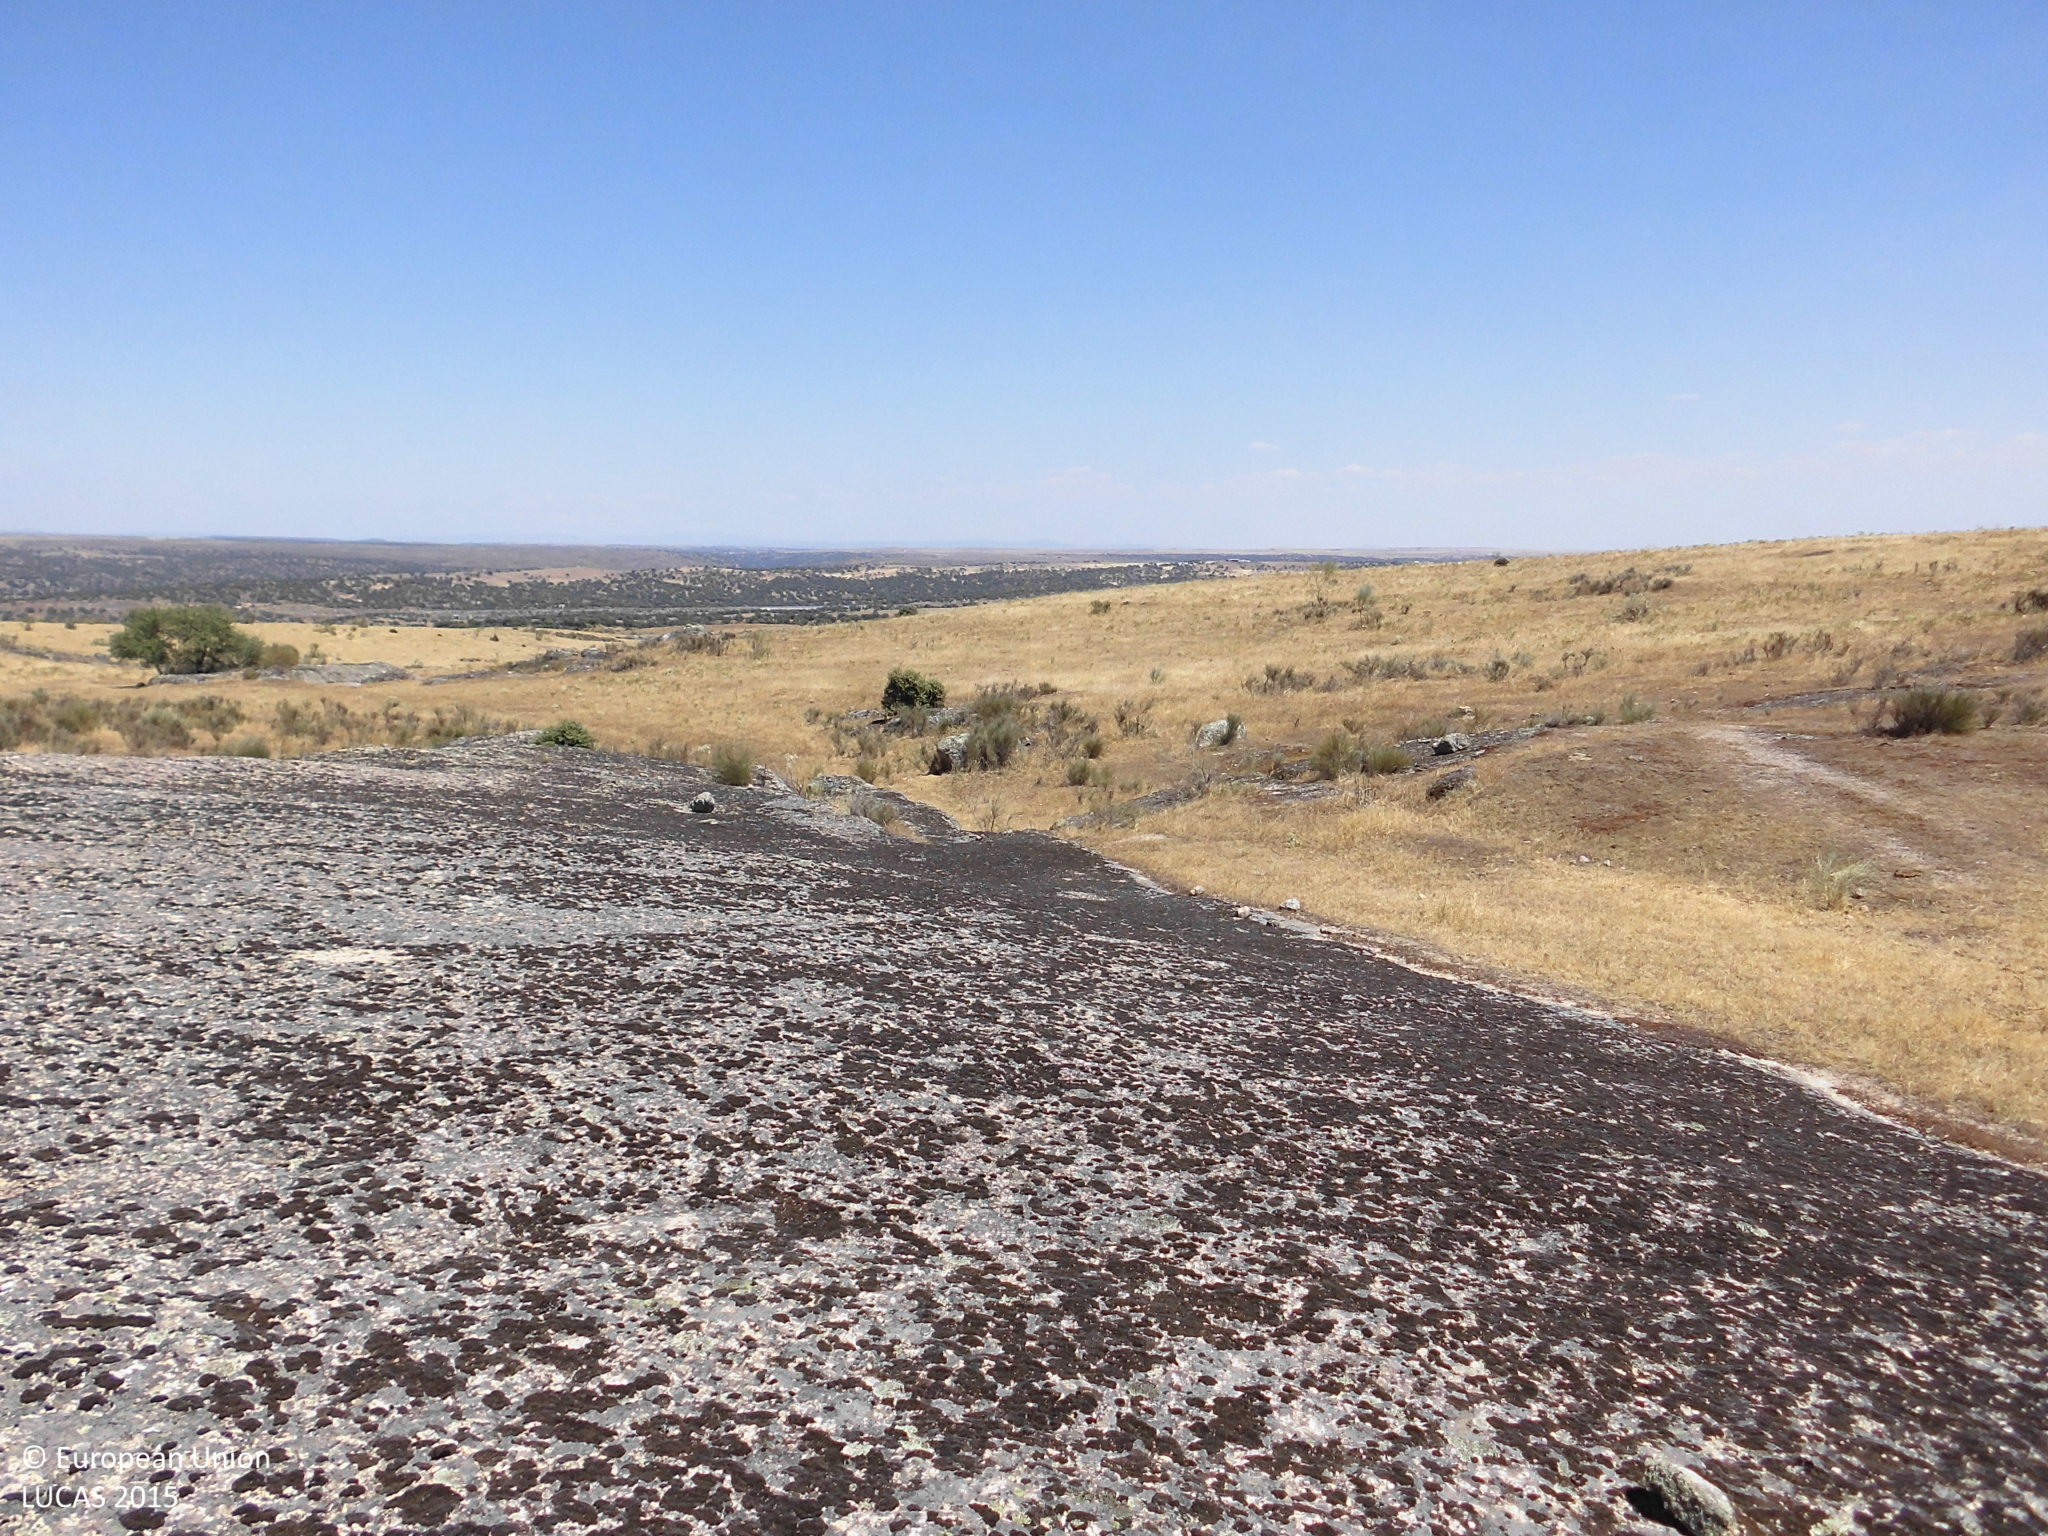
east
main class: Grassland
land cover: Grassland without tree/shrub cover
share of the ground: 25 - 50 %
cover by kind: consolidated bare surface 60 %, herbaceous plants 40 %
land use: Agriculture (excluding fallow land and kitchen gardens)
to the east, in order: Grassland without tree/shrub cover; Rocks and stones; Grassland without tree/shrub cover; Rocks and stones; Grassland without tree/shrub cover
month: June
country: ES
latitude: 39.6074
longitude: -6.4354
